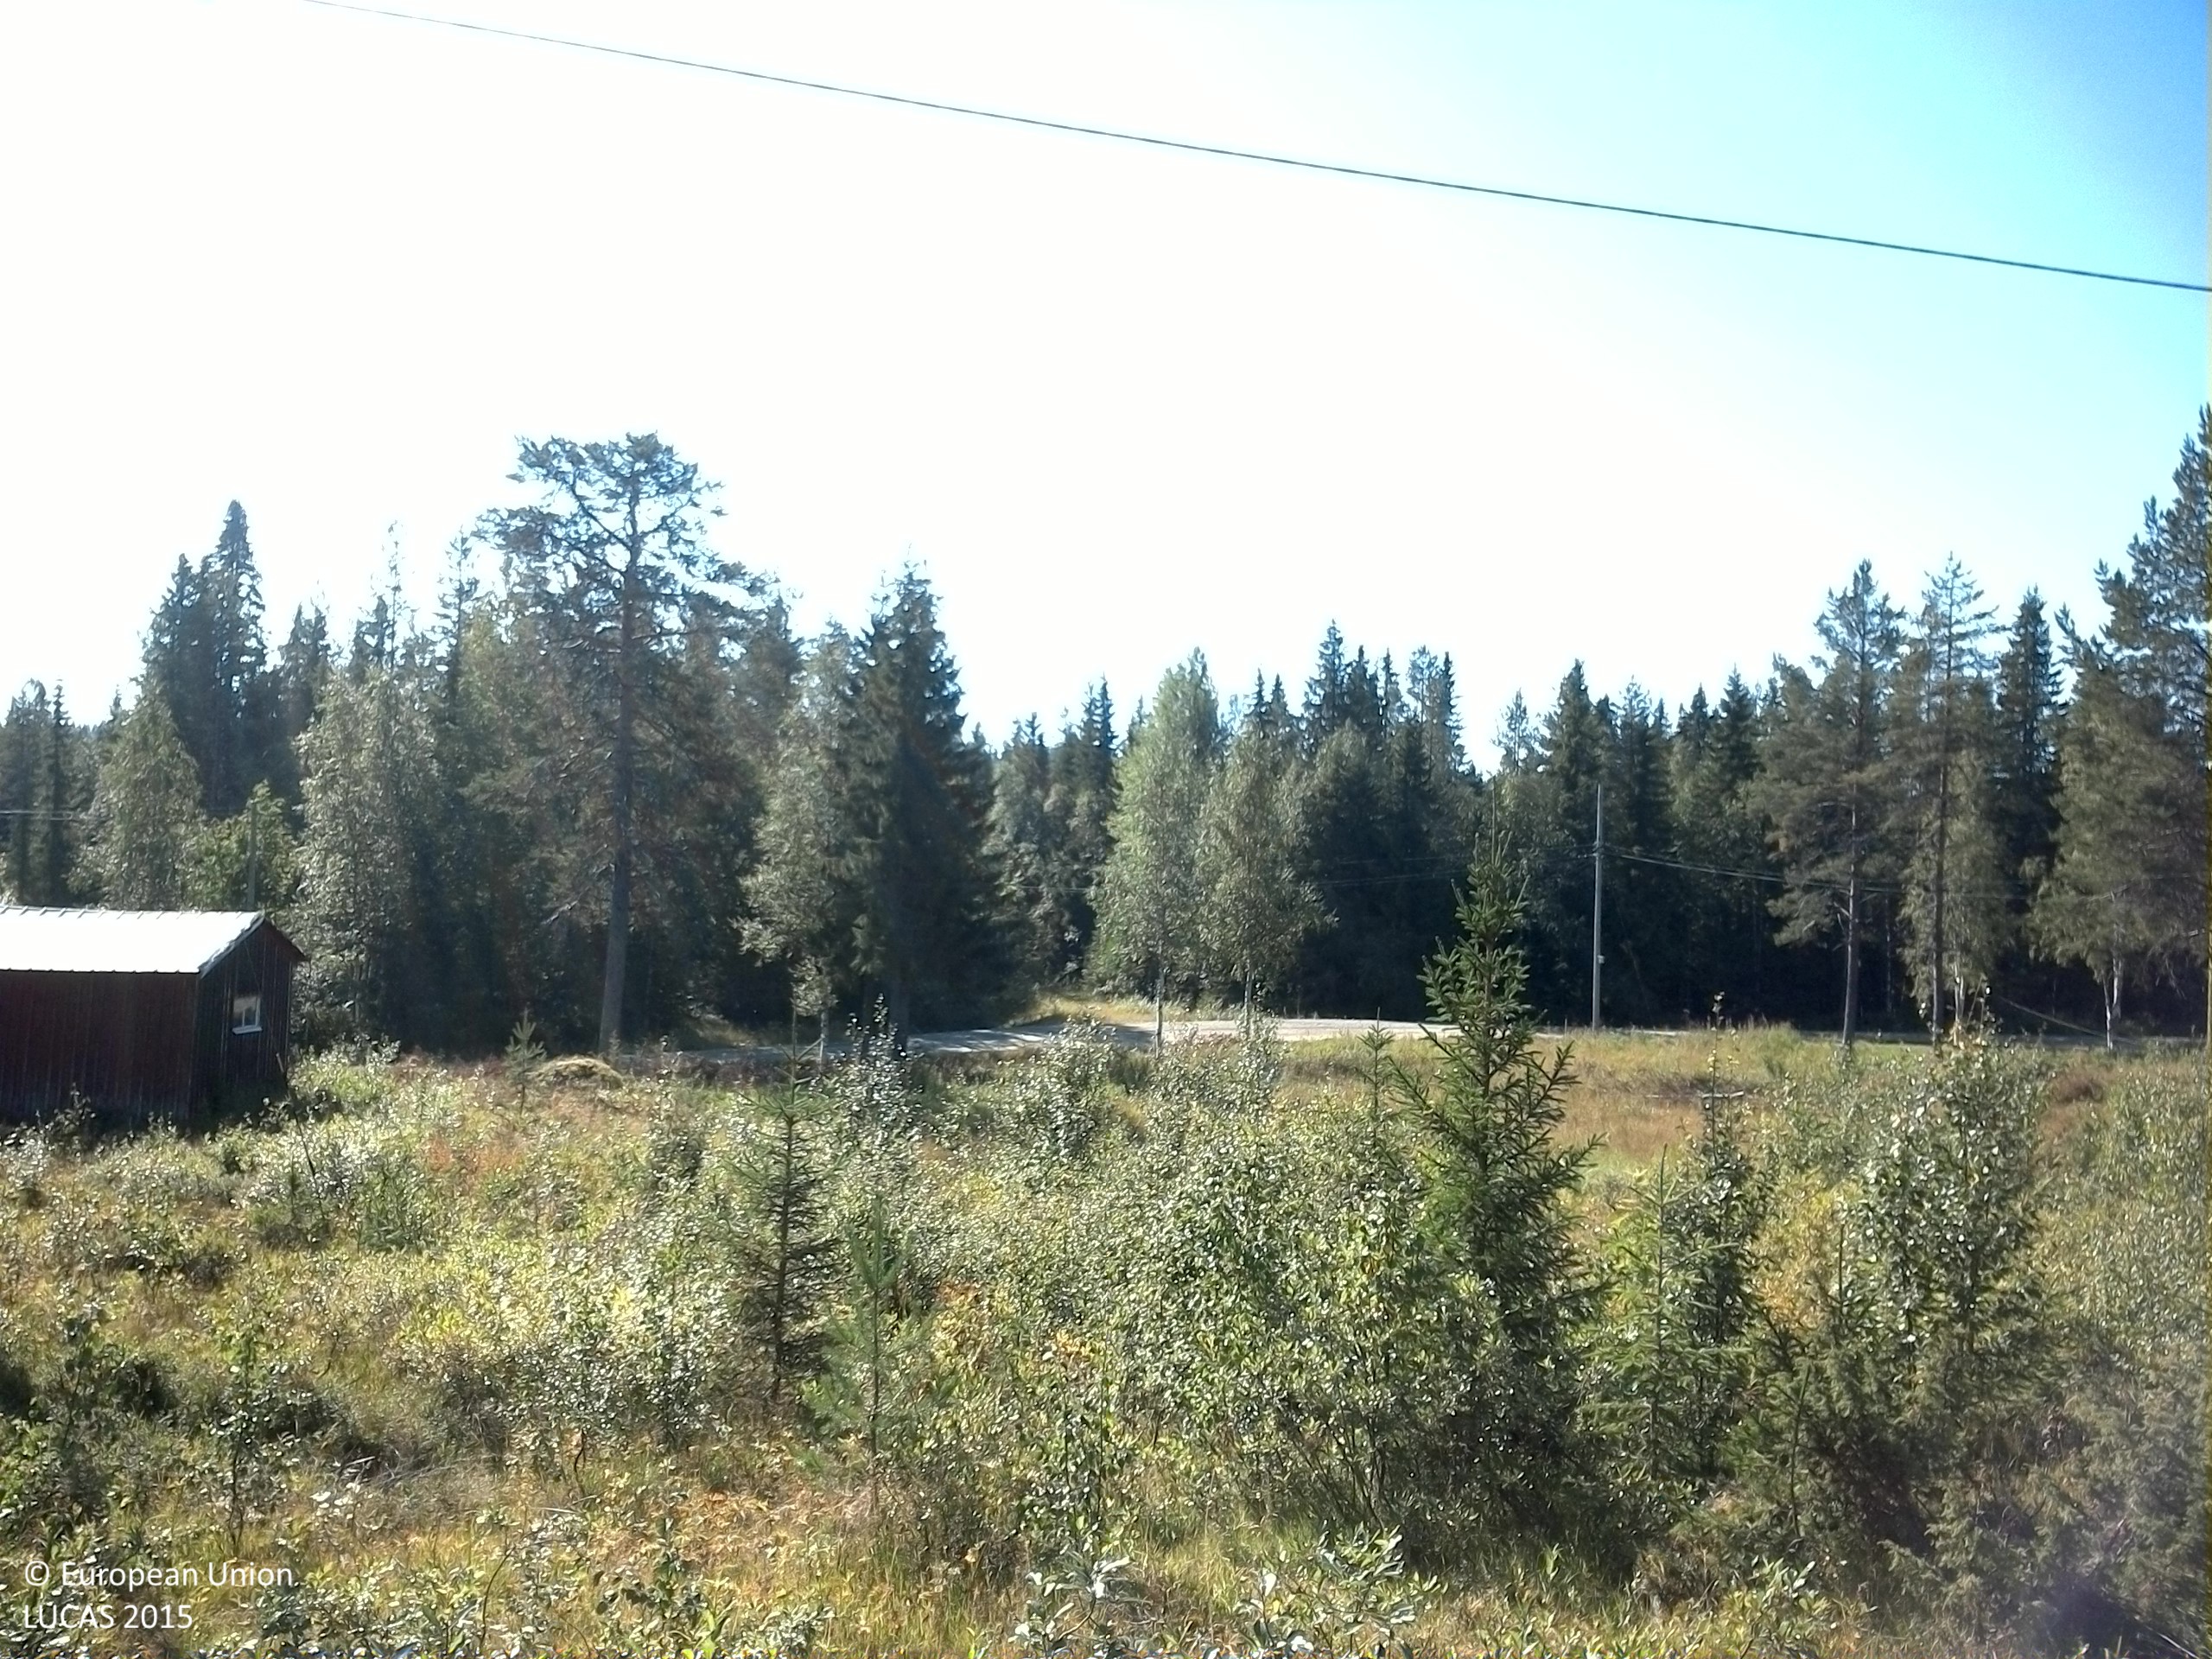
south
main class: Woodland
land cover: Spruce dominated mixed woodland
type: boreal forest
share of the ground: 25 - 50 %
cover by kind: herbaceous plants 50 %, coniferous forest trees 15 %, broadleaved forest trees 15 %, shrubs 15 %, lichens and mosses 5 %
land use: Residential
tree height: < 5 m
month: August
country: SE
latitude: 63.7693
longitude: 17.4551
